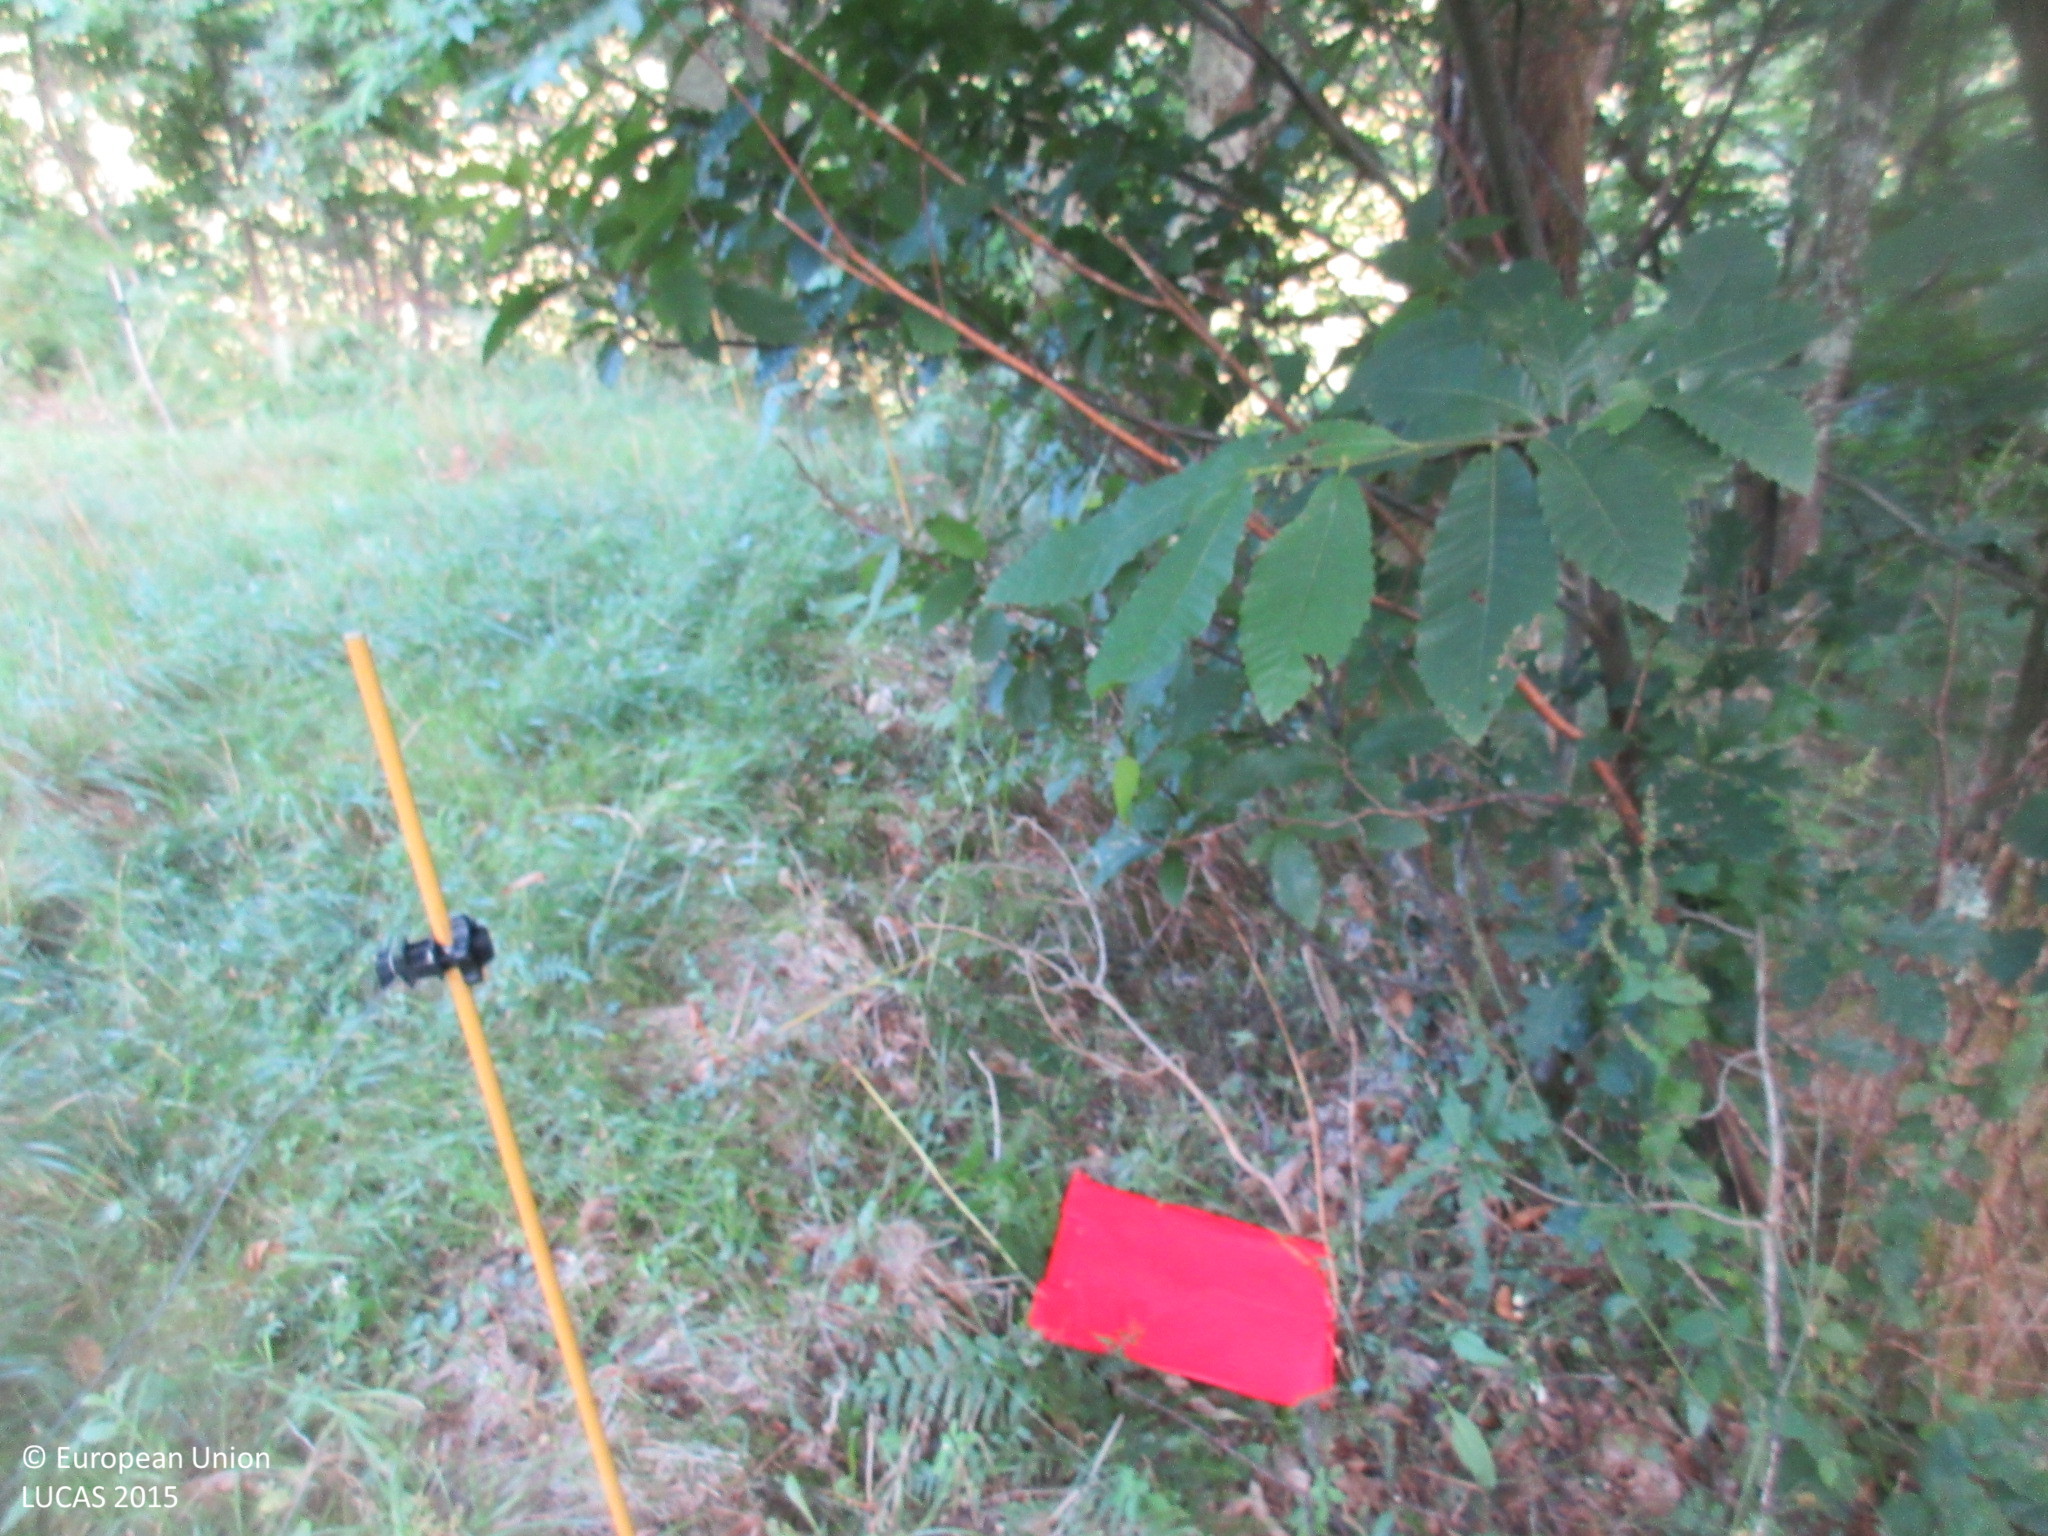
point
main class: Woodland
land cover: Broadleaved woodland
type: thermophilous deciduous forest
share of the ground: > 75 %
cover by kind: broadleaved forest trees 95 %, shrubs 5 %
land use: Forestry
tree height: > 5 m
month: July
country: ES
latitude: 43.3926
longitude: -5.0462
